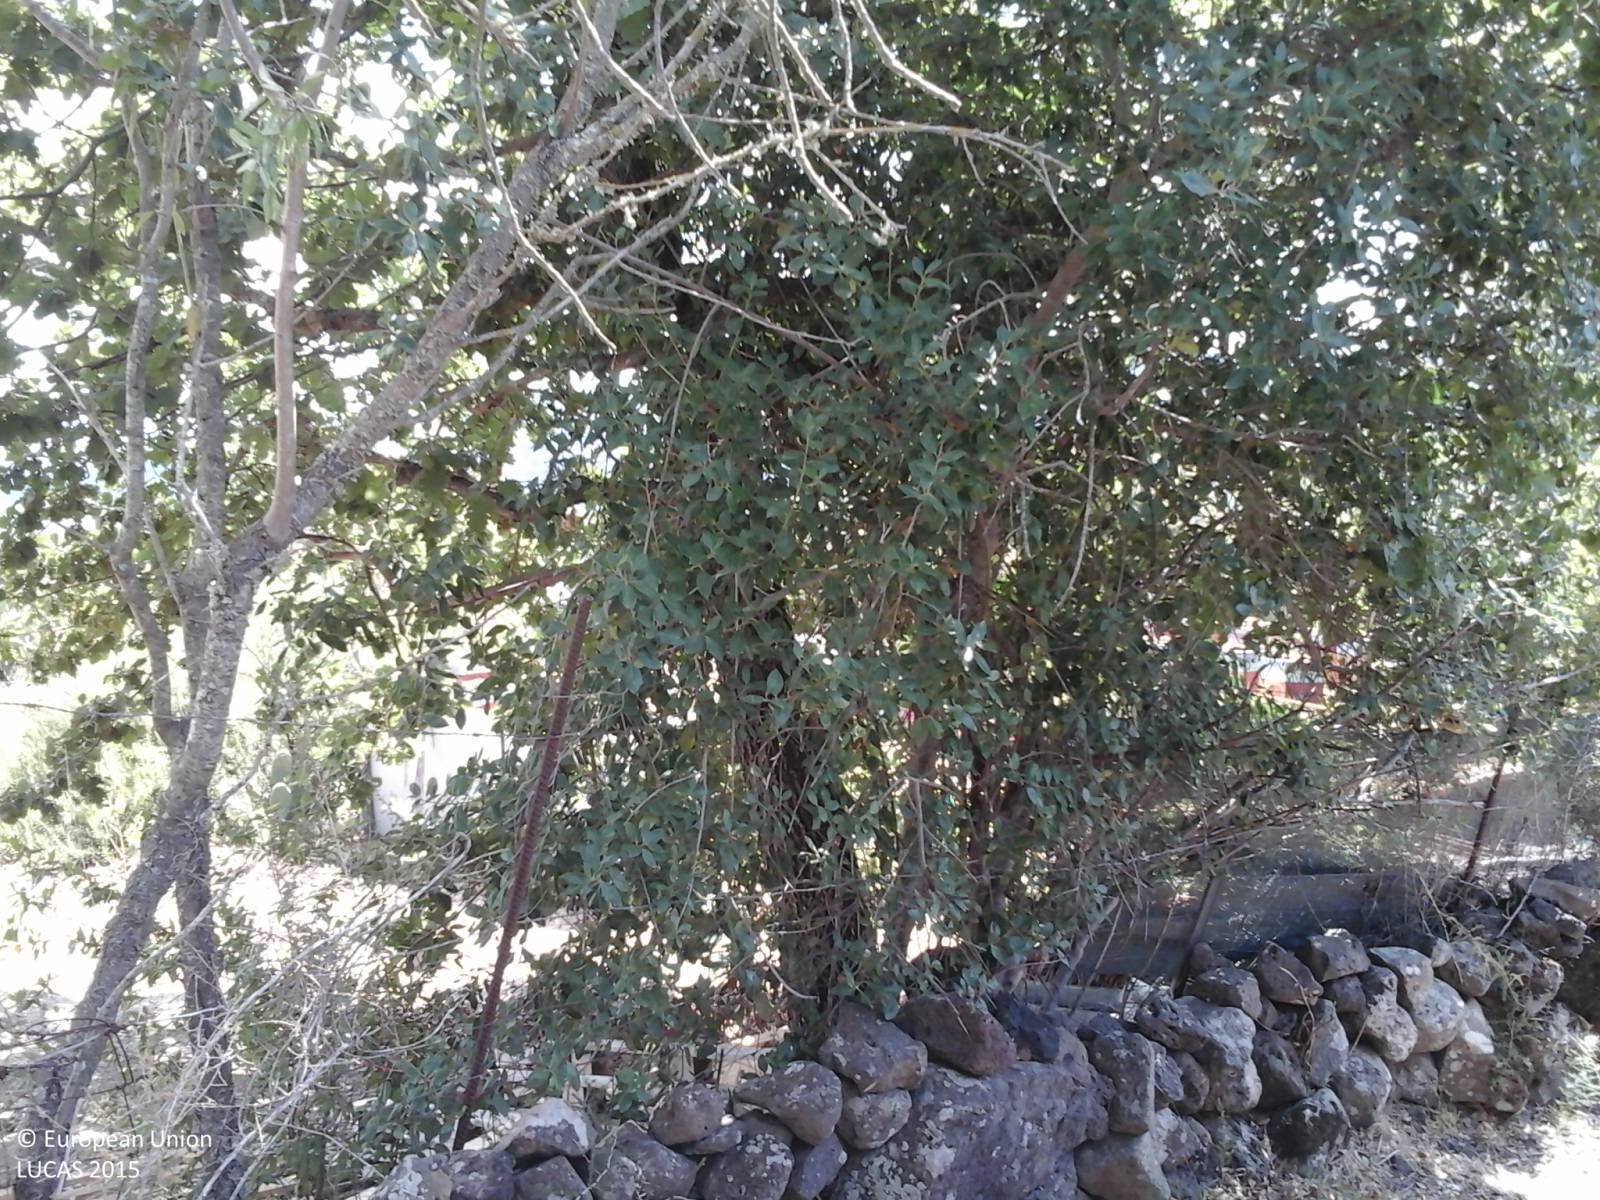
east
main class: Cropland
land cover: Olive groves
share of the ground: > 75 %
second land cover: Grassland without tree/shrub cover
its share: > 75 %
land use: Agriculture (excluding fallow land and kitchen gardens)
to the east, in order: Olive groves; Grassland without tree/shrub cover; Broadleaved woodland; Abandoned hedges; Olive groves; Broadleaved woodland; Inland fresh water bodies
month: August
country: IT
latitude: 40.1162
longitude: 8.8913
